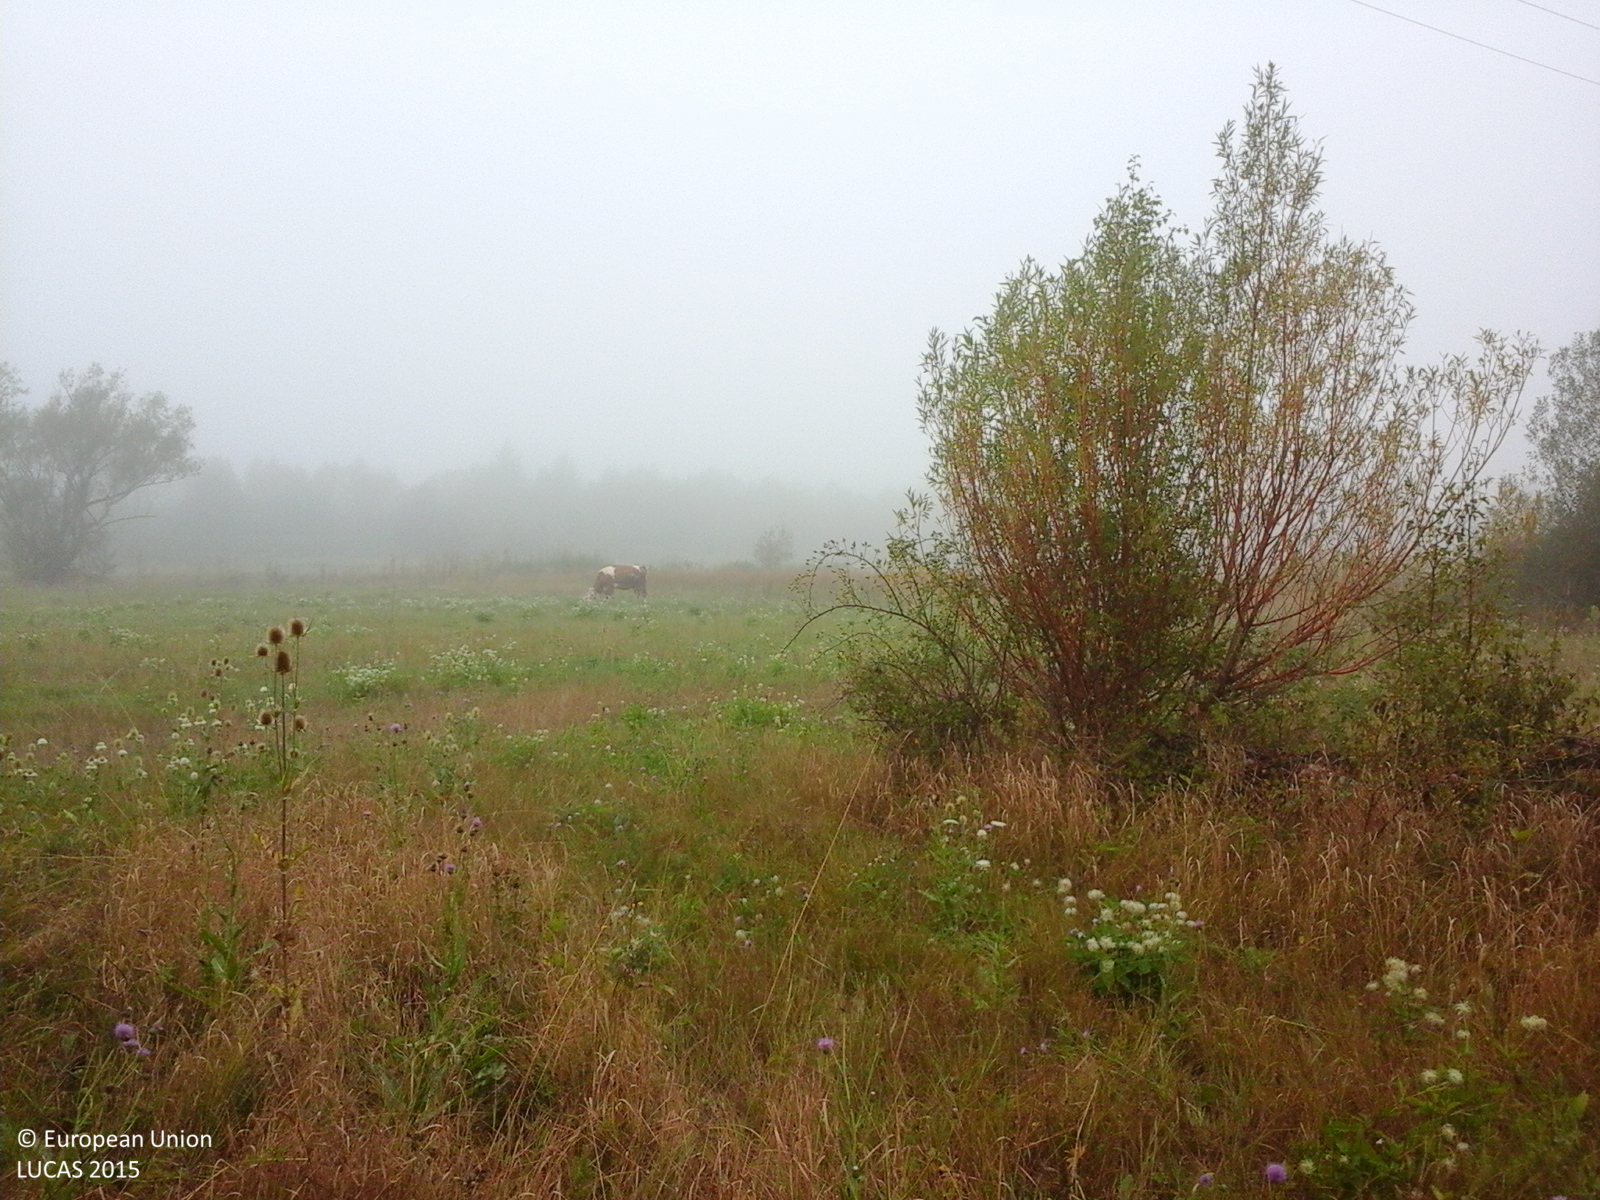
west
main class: Grassland
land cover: Grassland with sparse tree/shrub cover
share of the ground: > 75 %
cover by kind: herbaceous plants 90 %, broadleaved forest trees 5 %, shrubs 5 %
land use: Agriculture (excluding fallow land and kitchen gardens)
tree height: < 5 m
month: August
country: RO
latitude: 44.9589
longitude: 21.5527
